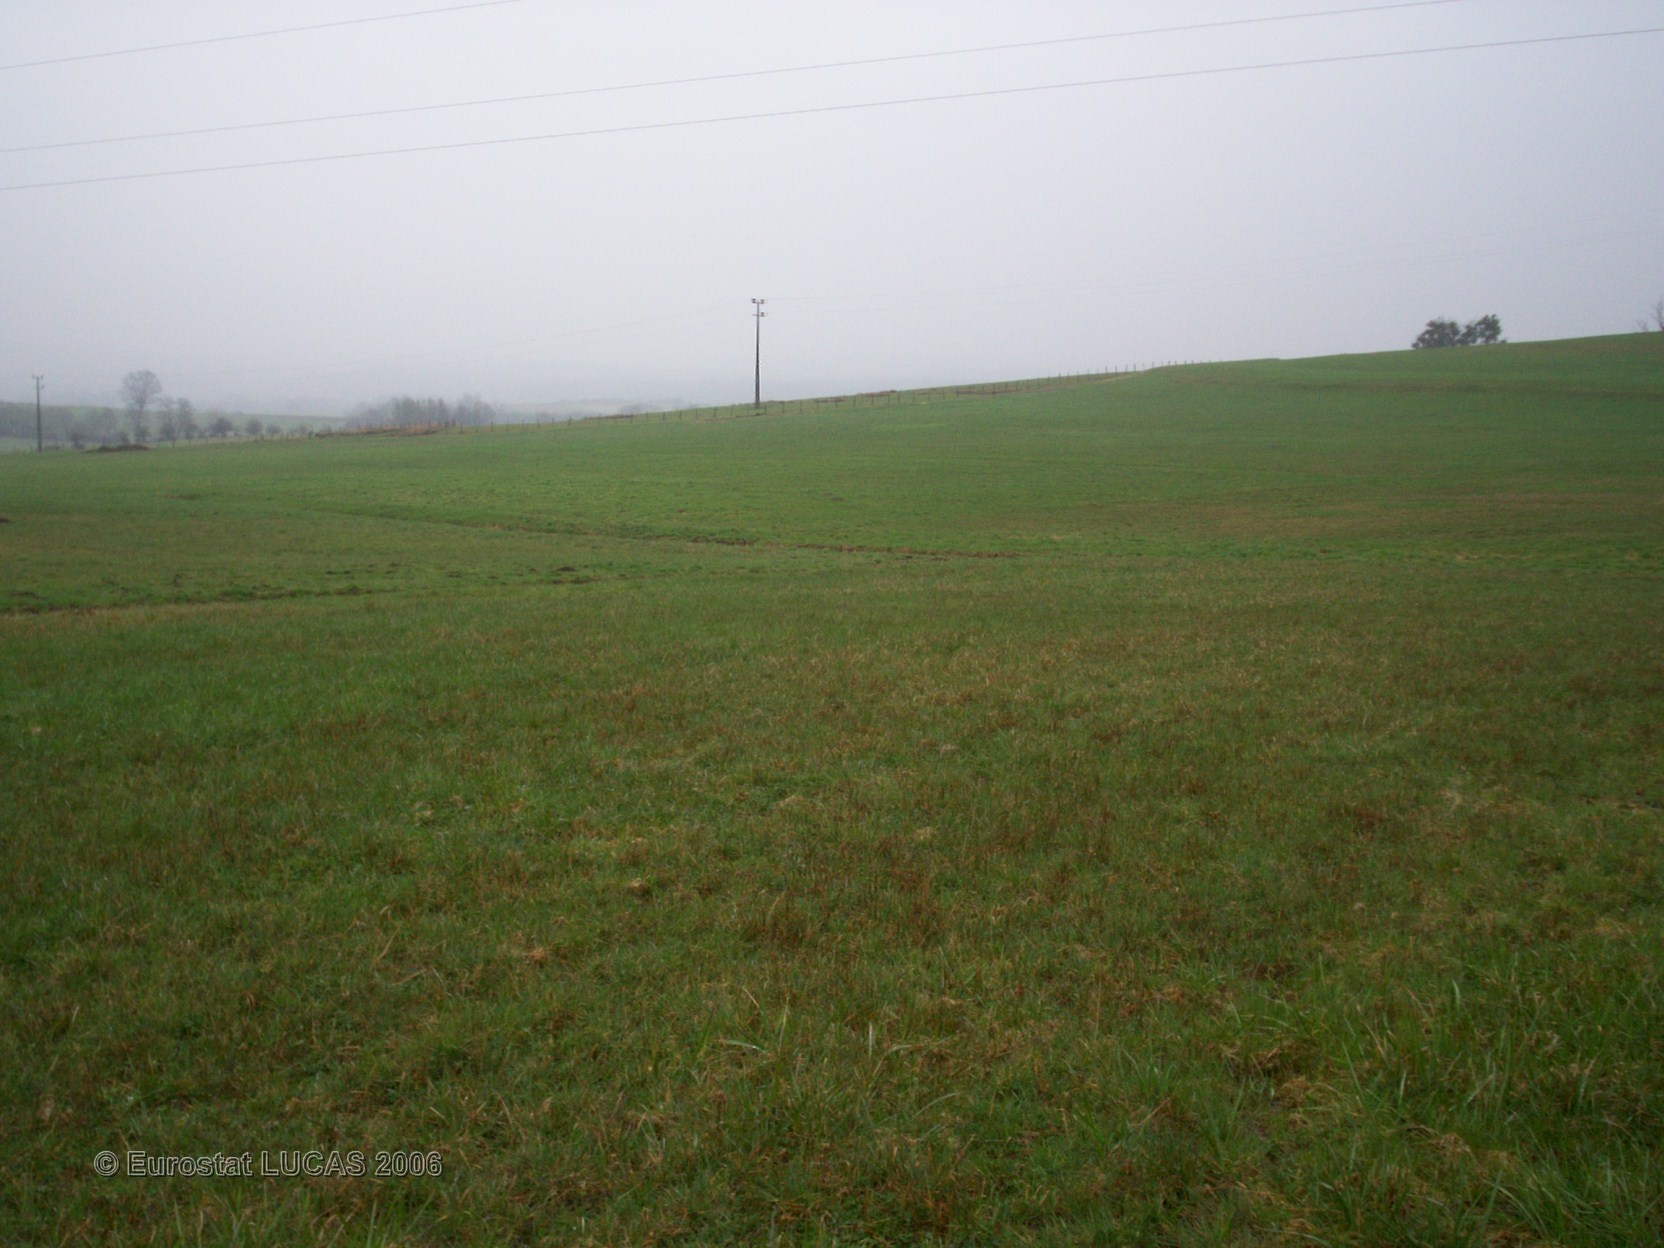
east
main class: Grassland
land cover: Grassland without tree/shrub cover
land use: Agriculture (excluding fallow land and kitchen gardens)
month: April
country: FR
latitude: 47.6661
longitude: 6.5789
